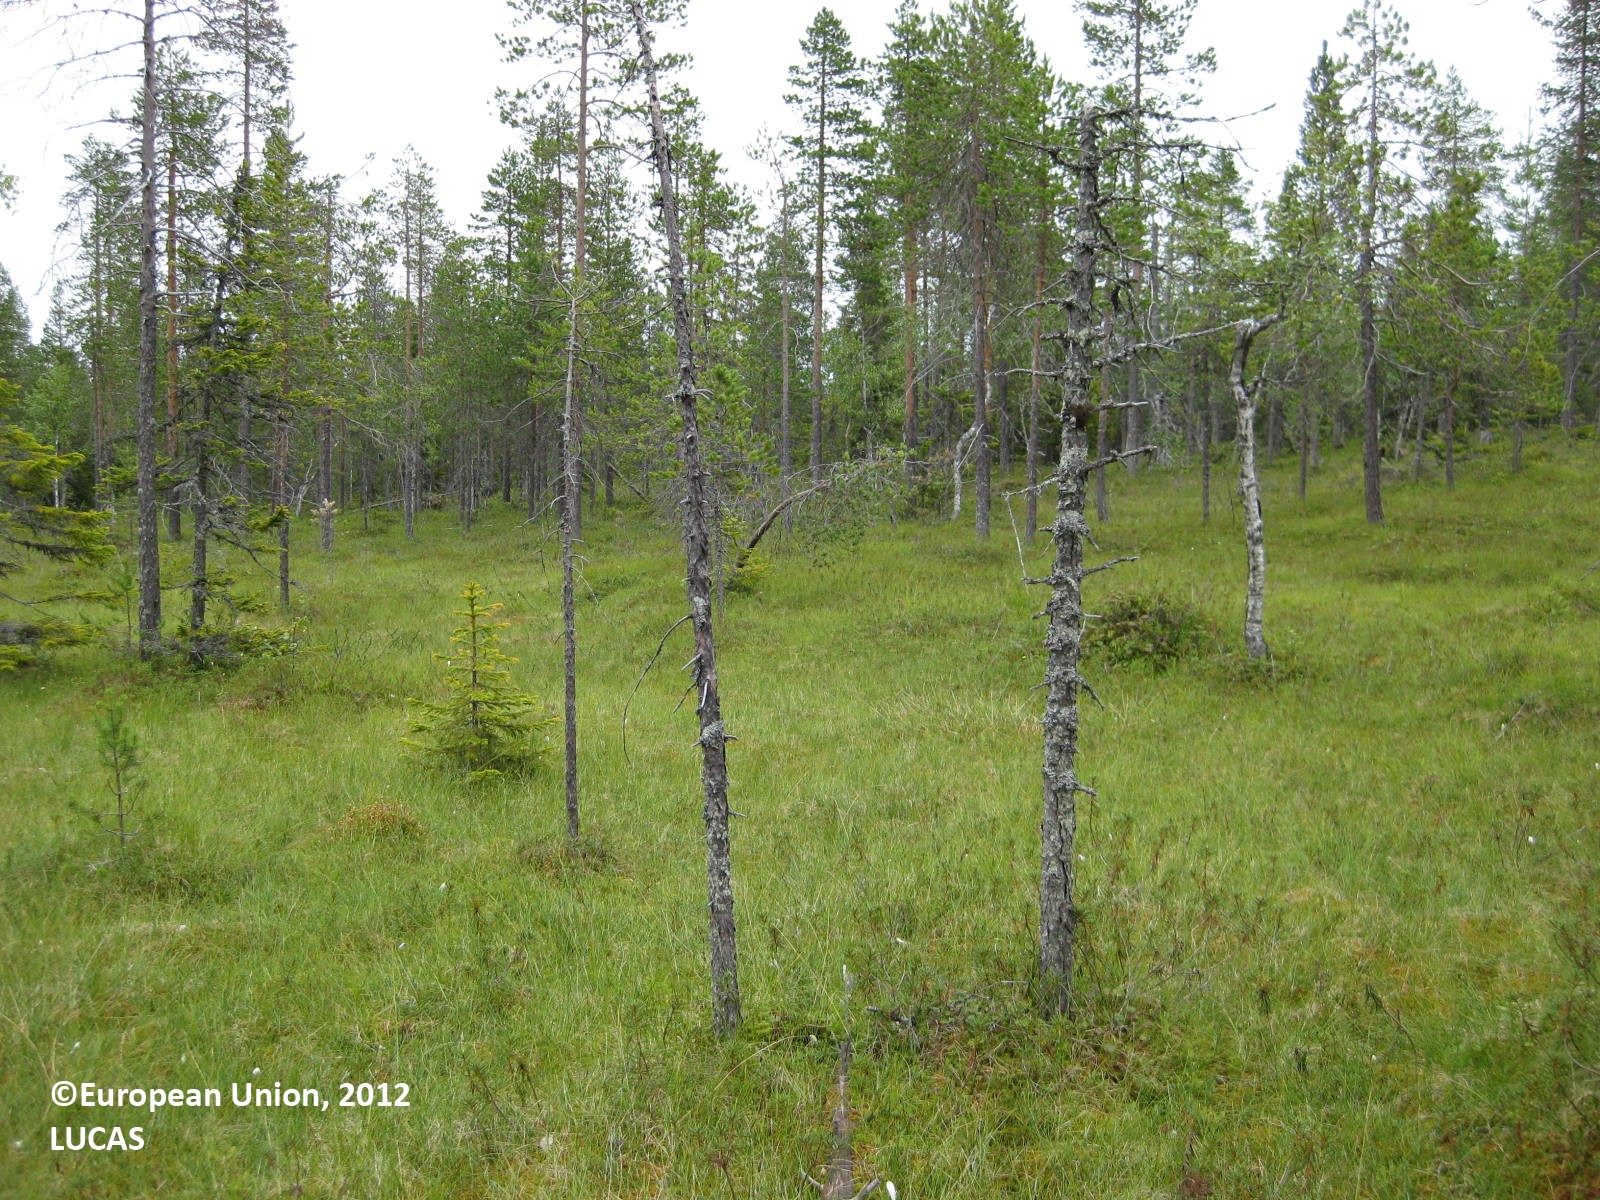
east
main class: Woodland
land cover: Pine dominated coniferous woodland
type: boreal forest
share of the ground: 10 - 25 %
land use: Semi-natural and natural areas not in use
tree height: > 5 m
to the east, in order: Pine dominated coniferous woodland; Other coniferous woodland
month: August
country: FI
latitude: 66.0152
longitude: 28.2452
